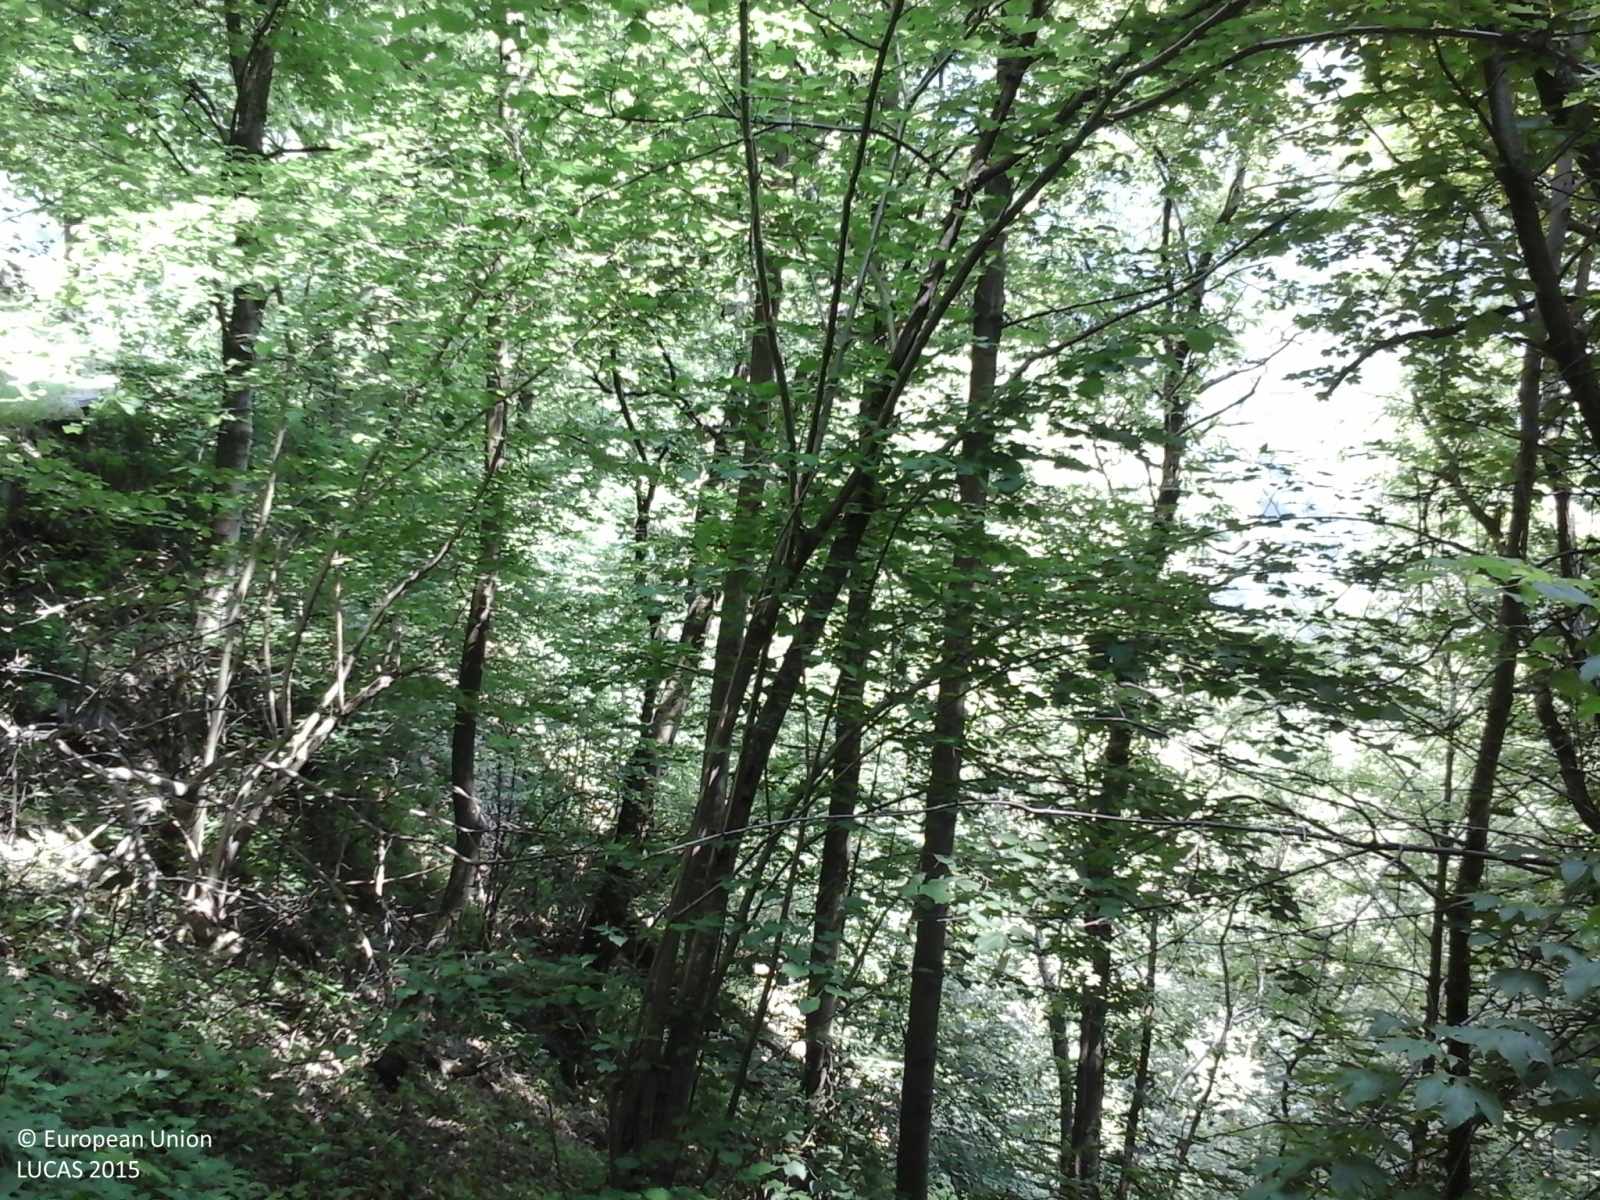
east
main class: Woodland
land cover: Broadleaved woodland
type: beech forest
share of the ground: > 75 %
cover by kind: broadleaved forest trees 100 %
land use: Forestry
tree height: > 5 m
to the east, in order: Broadleaved woodland
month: June
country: IT
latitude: 45.8682
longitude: 8.2377
